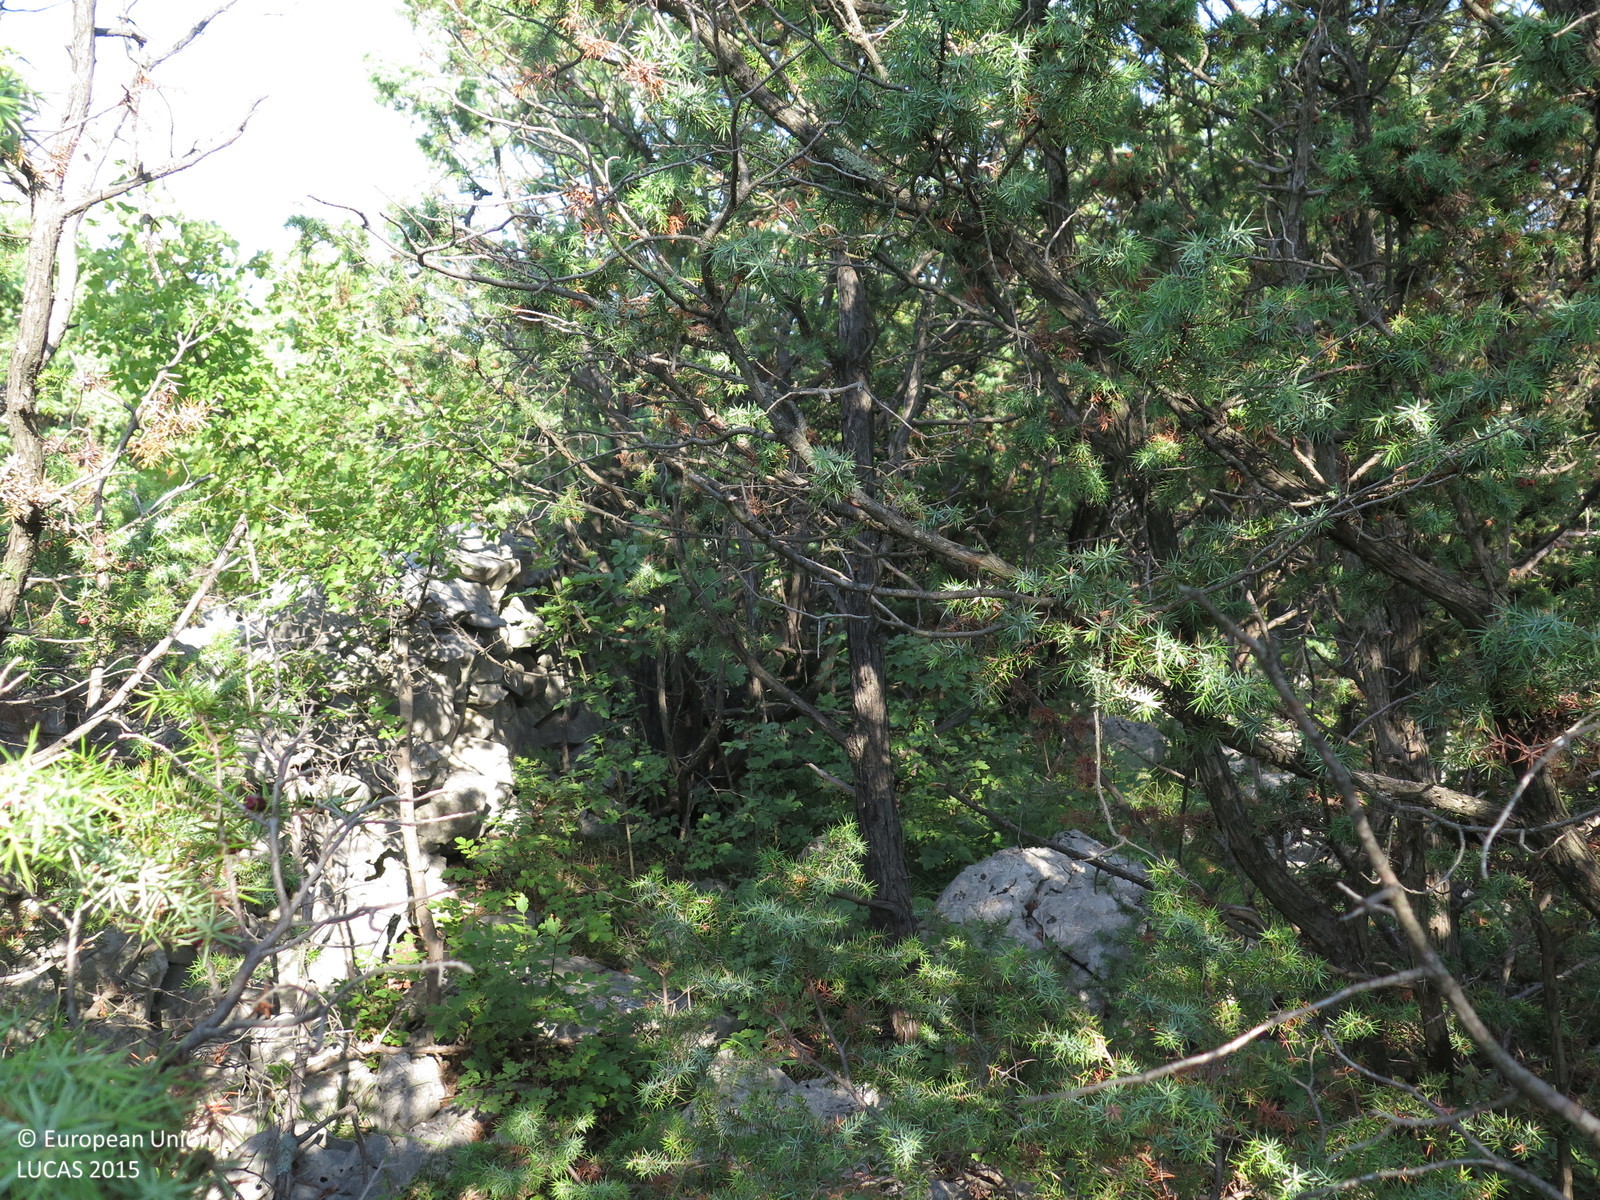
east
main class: Woodland
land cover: Broadleaved woodland
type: thermophilous deciduous forest
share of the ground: > 75 %
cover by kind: broadleaved forest trees 90 %, shrubs 5 %, unconsolidated bare surface 5 %
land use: Semi-natural and natural areas not in use
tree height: < 5 m
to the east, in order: Broadleaved woodland; Dry stone walls; Grassland with sparse tree/shrub cover; Broadleaved woodland; Shrubland with sparse tree cover; Broadleaved woodland
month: August
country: HR
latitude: 45.0408
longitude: 14.6534
